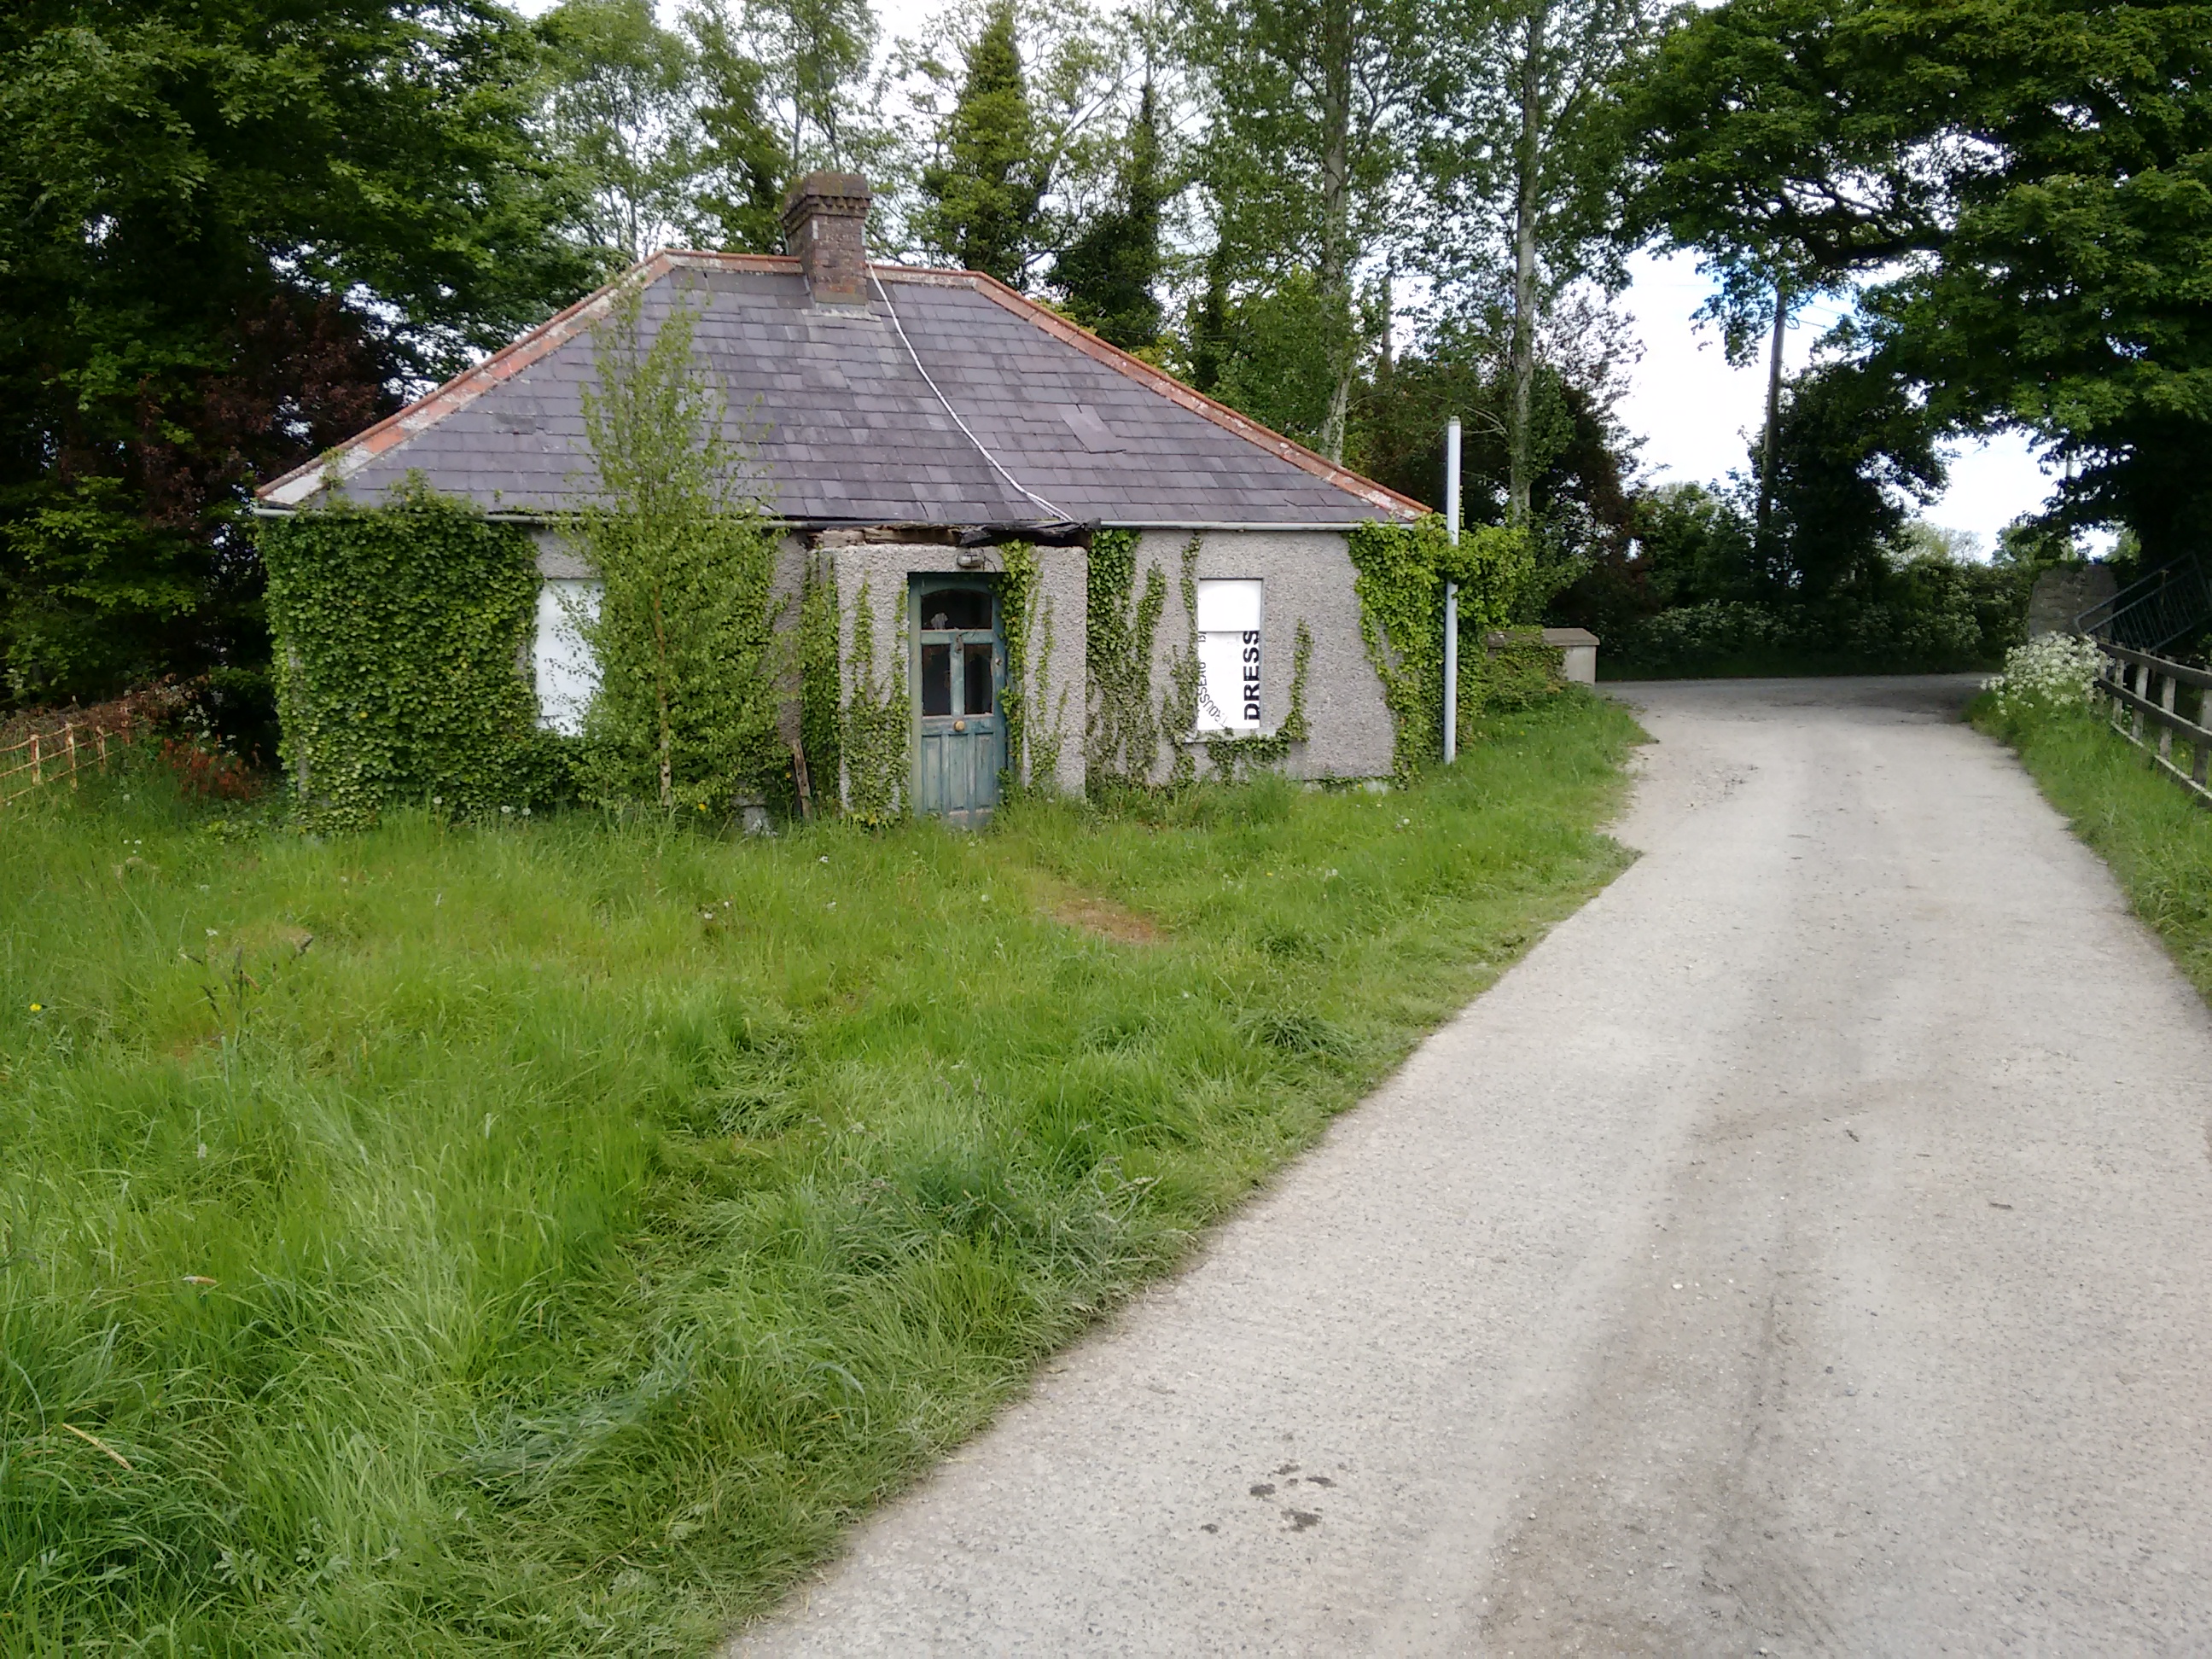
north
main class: Grassland
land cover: Grassland without tree/shrub cover
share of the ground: > 75 %
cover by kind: herbaceous plants 100 %
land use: Agriculture (excluding fallow land and kitchen gardens)
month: May
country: IE
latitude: 53.5019
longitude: -6.5459
